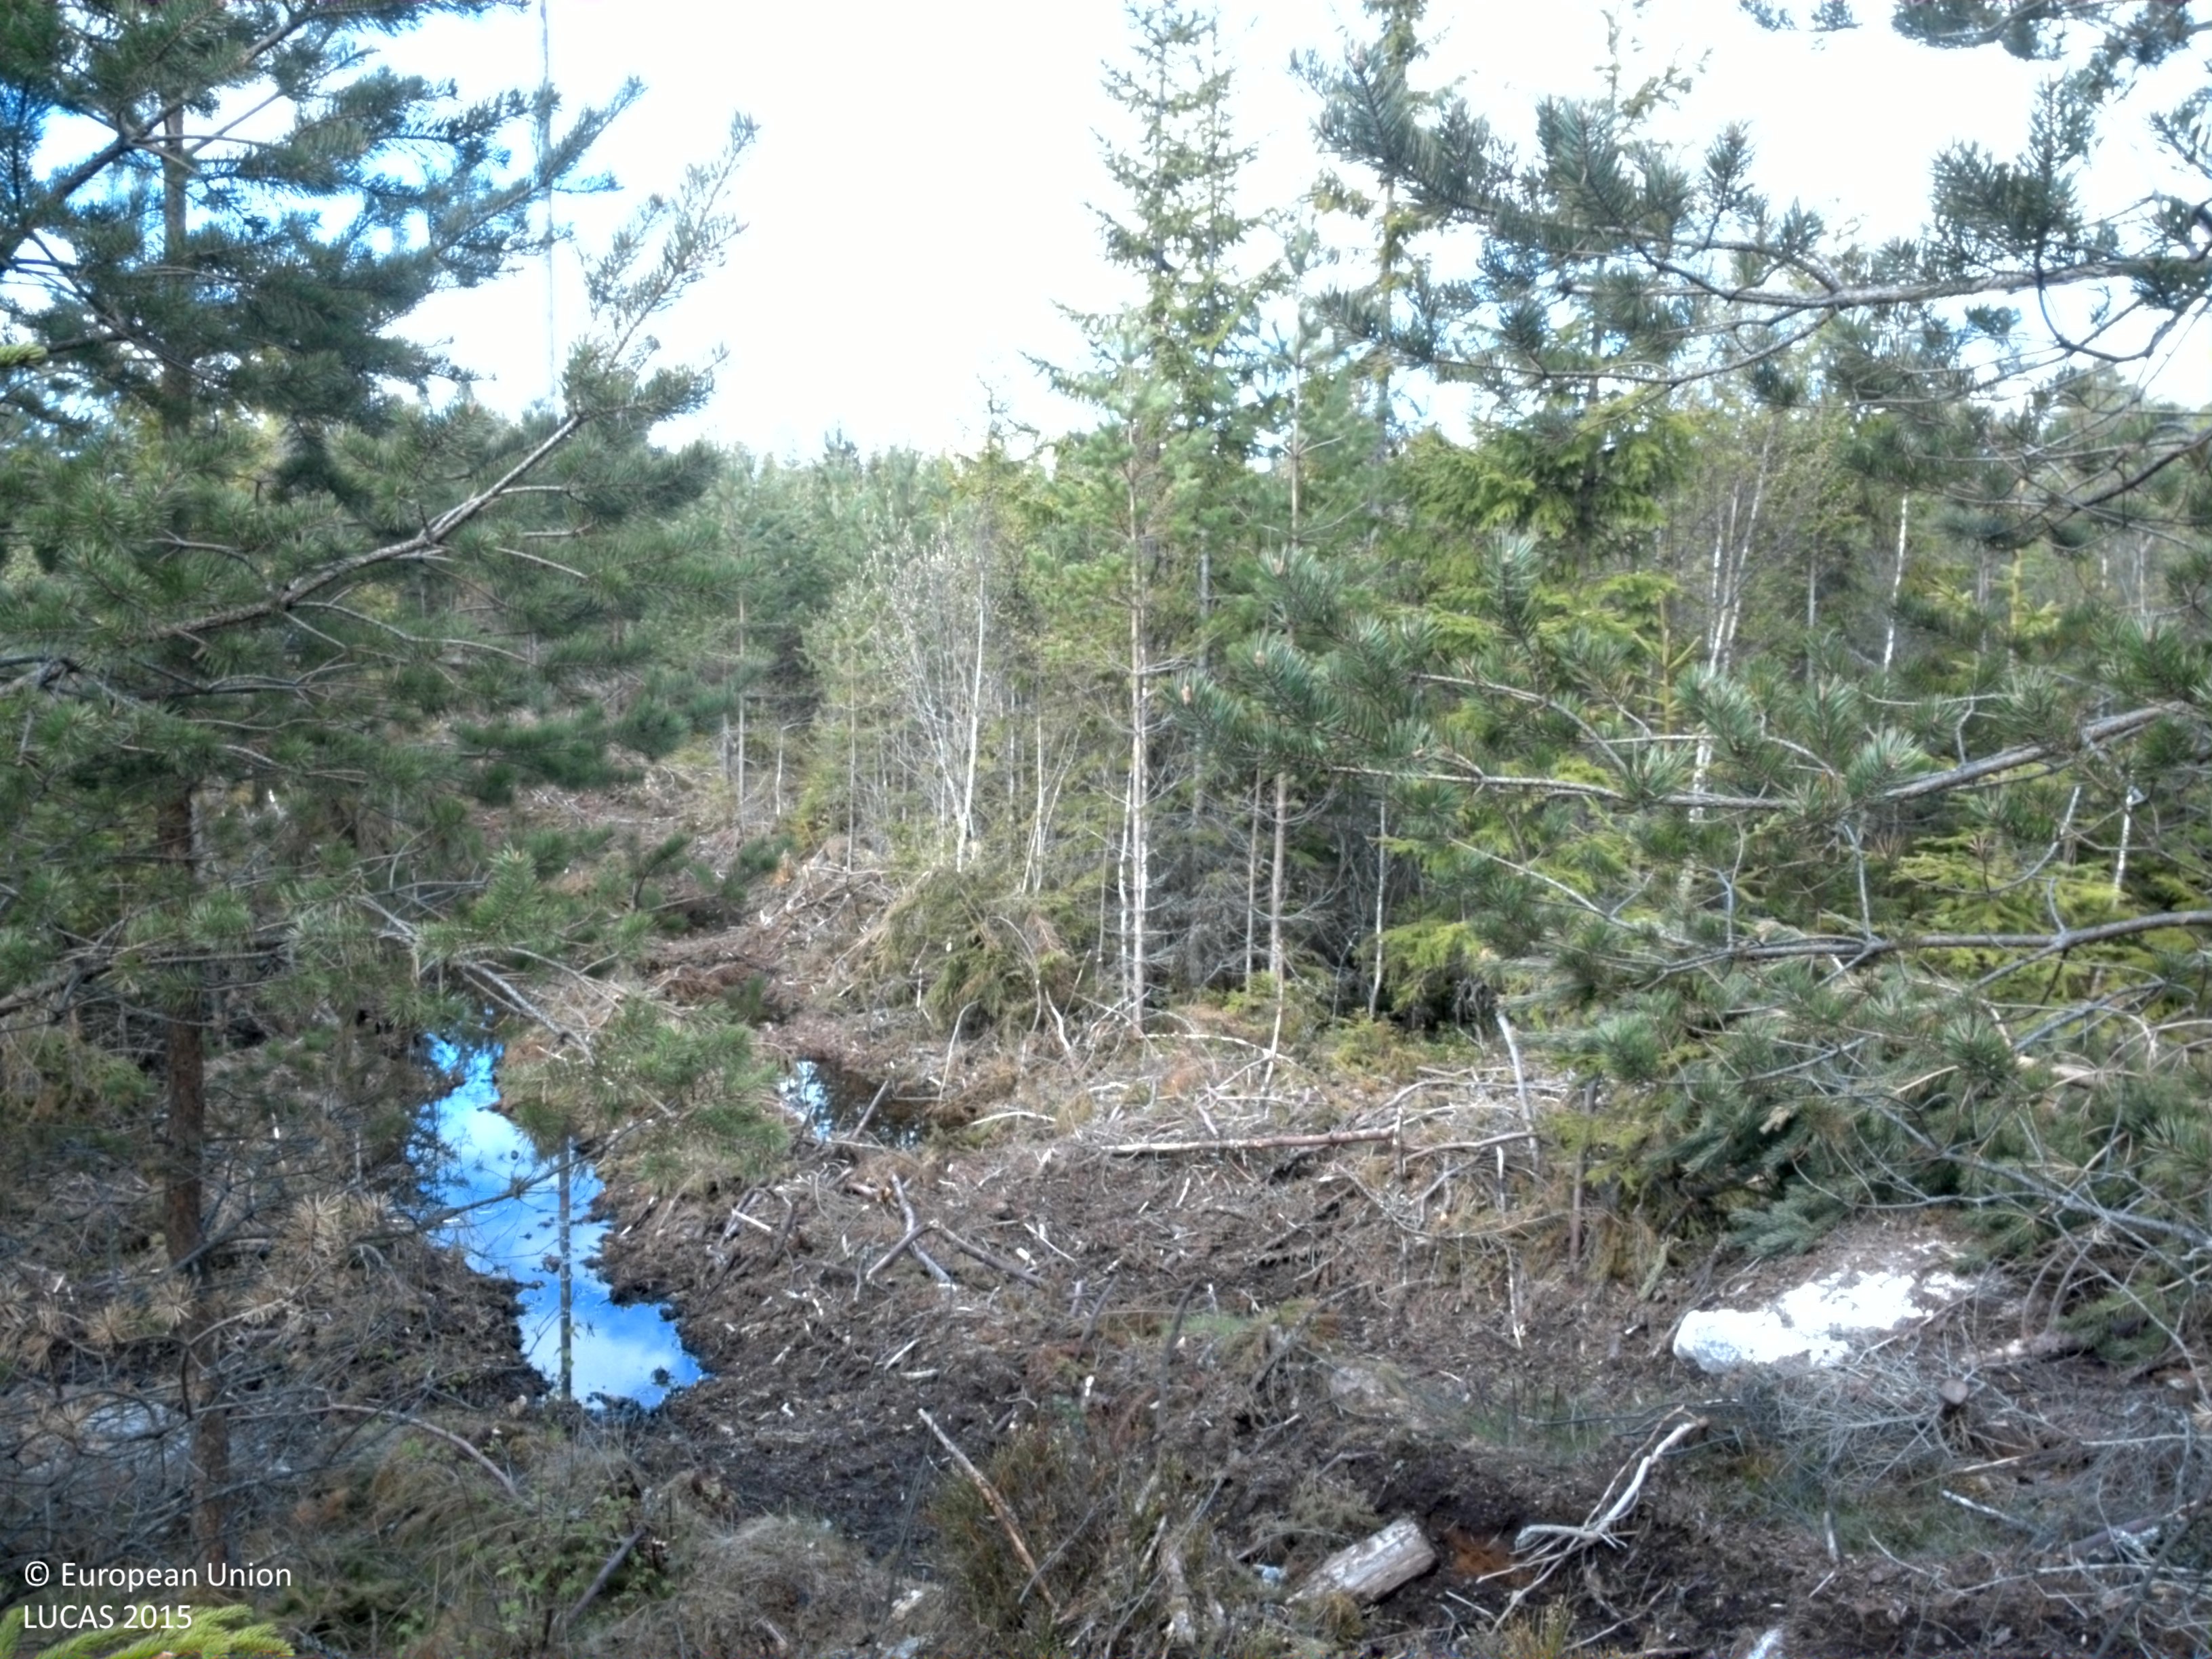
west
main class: Woodland
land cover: Other coniferous woodland
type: boreal forest
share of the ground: > 75 %
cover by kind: coniferous forest trees 75 %, shrubs 10 %, lichens and mosses 10 %, consolidated bare surface 5 %
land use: Forestry
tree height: > 5 m
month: May
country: SE
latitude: 59.2301
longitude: 14.3553
